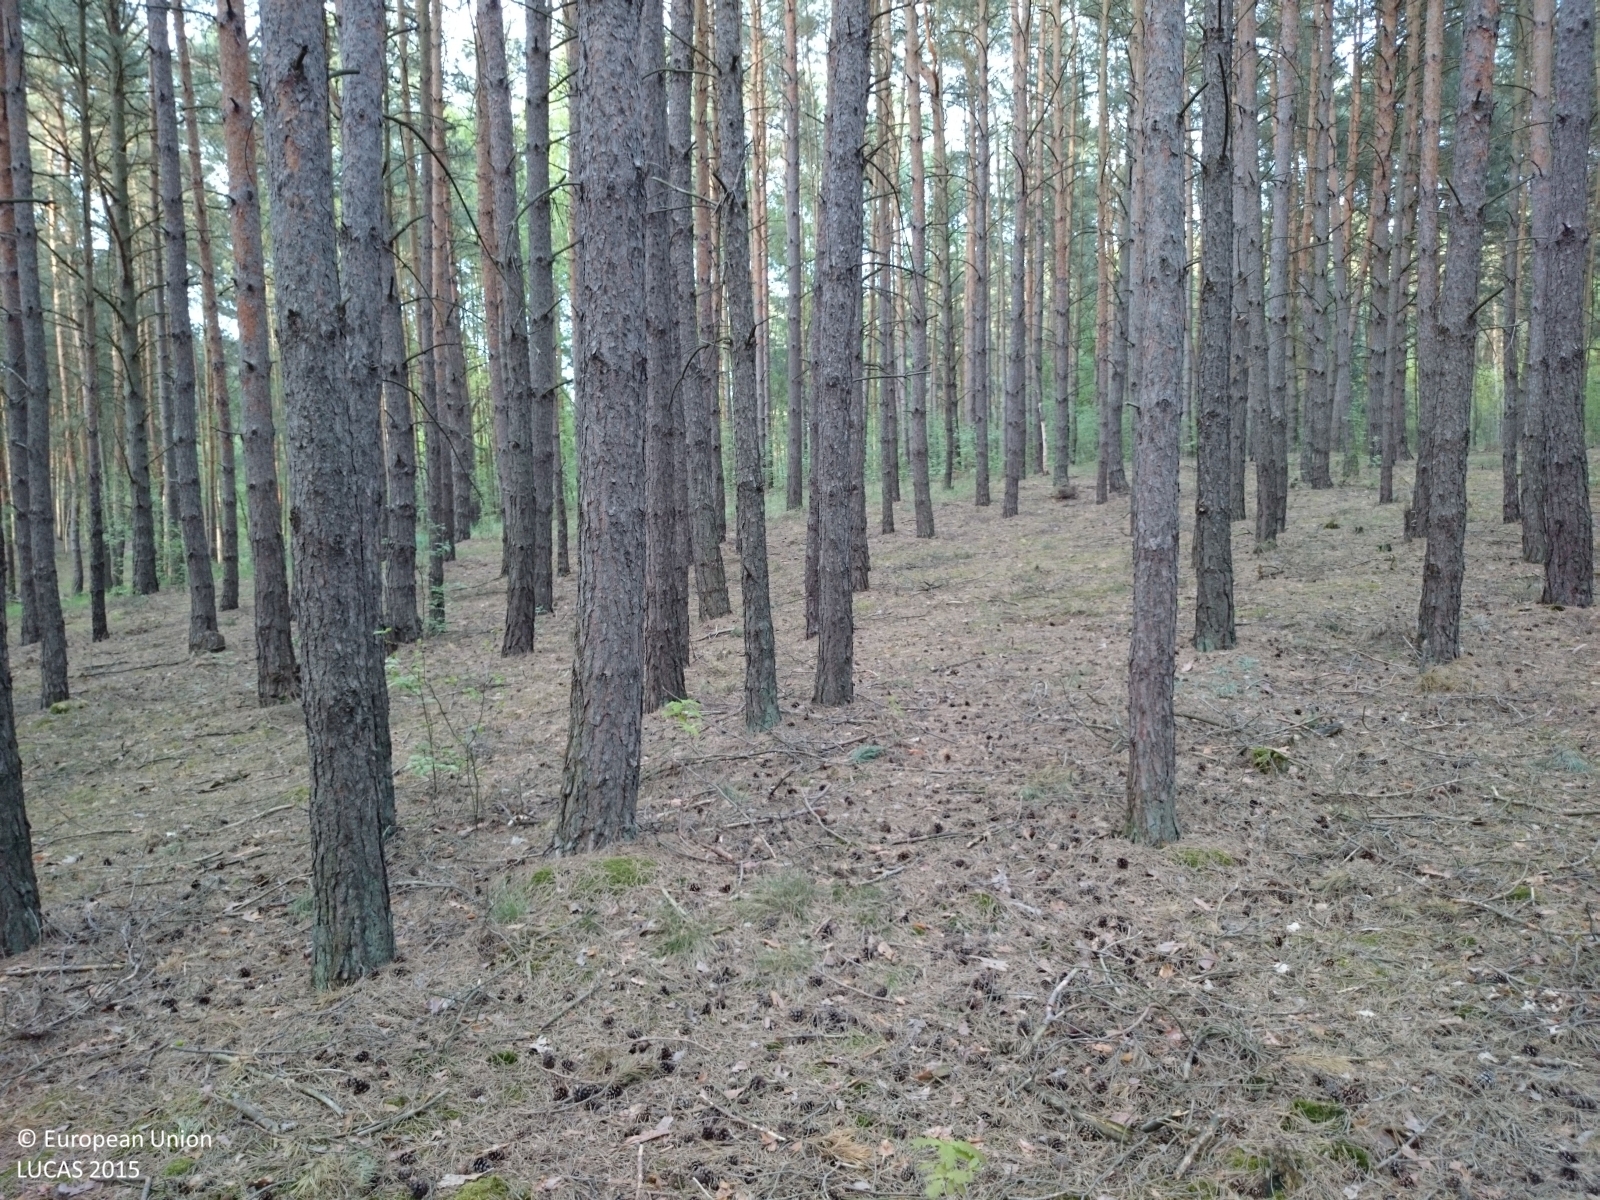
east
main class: Woodland
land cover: Pine dominated coniferous woodland
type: hemiboreal forest and nemoral coniferous forest and mixed broadleaved-coniferous forest
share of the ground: > 75 %
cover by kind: coniferous forest trees 100 %
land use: Forestry
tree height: > 5 m
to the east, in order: Pine dominated coniferous woodland; Railways; Abandoned hedges; Pine dominated coniferous woodland
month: May
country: PL
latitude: 52.6093
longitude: 16.2531
